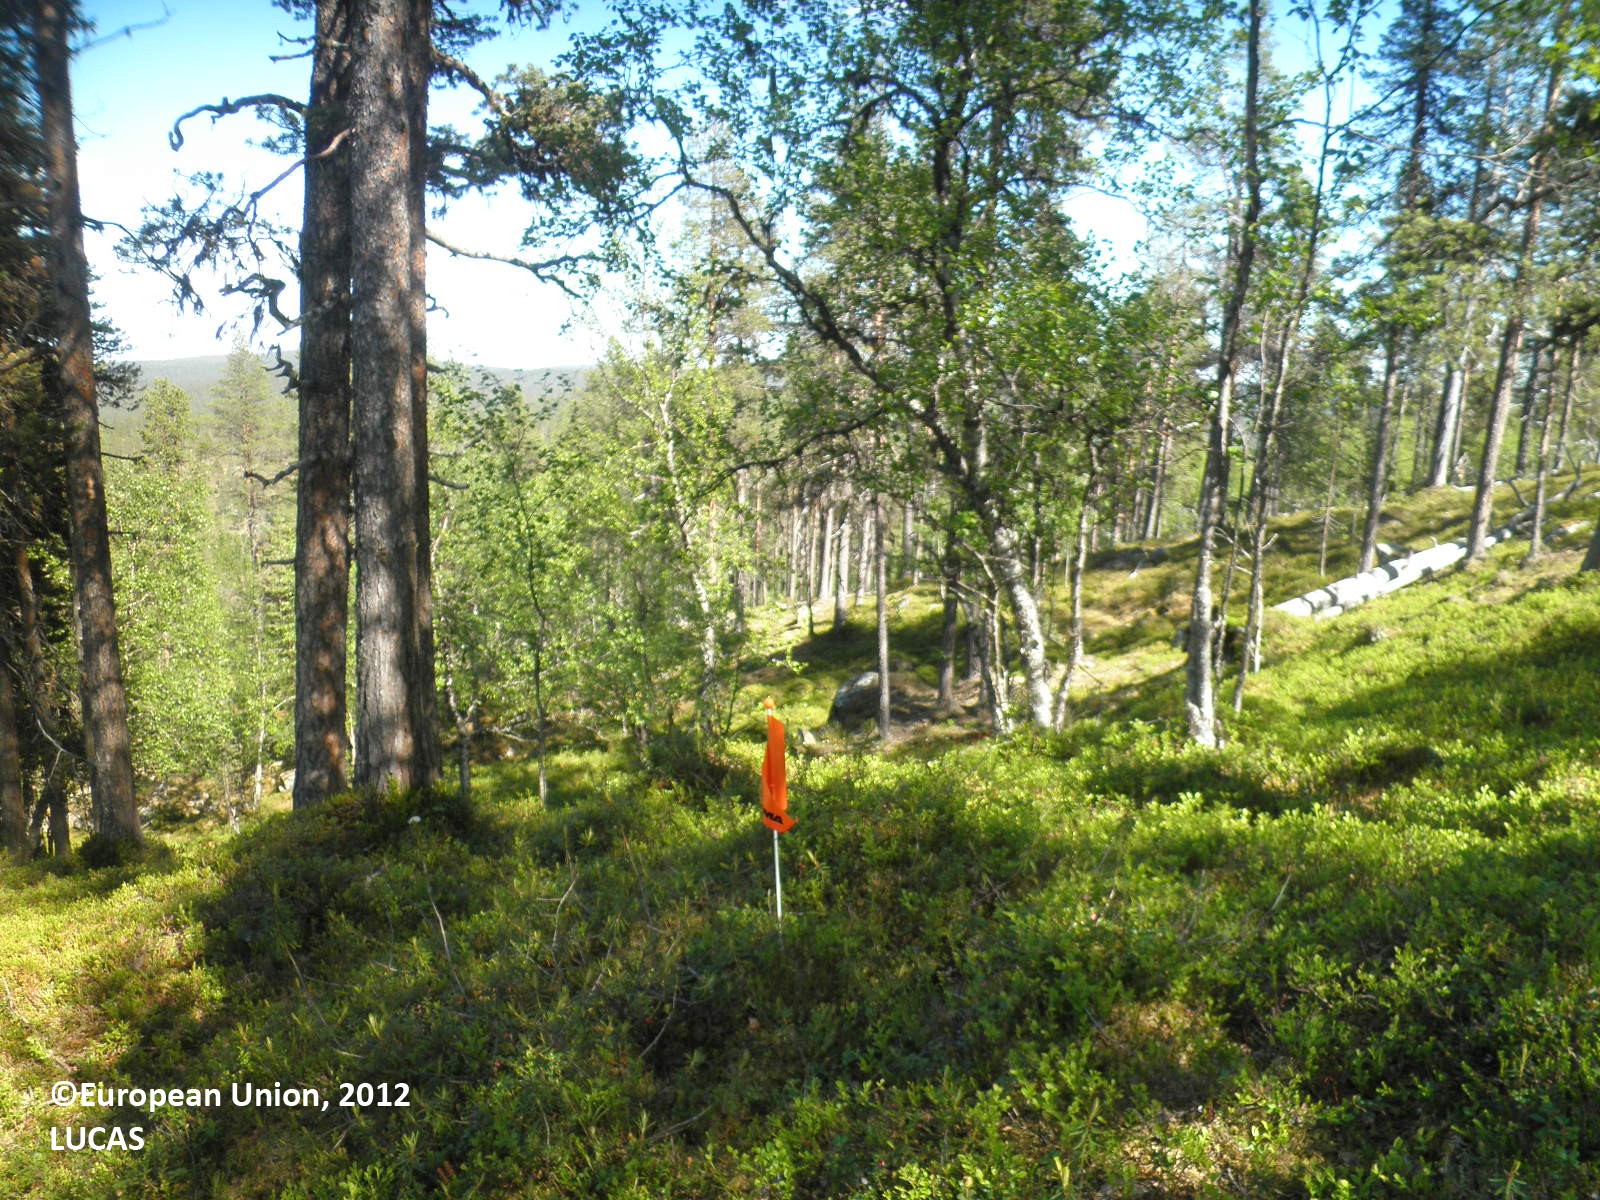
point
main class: Woodland
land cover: Pine dominated mixed woodland
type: boreal forest
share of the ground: 50 - 75 %
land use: Forestry
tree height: > 5 m
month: July
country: FI
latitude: 68.7795
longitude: 27.0200
